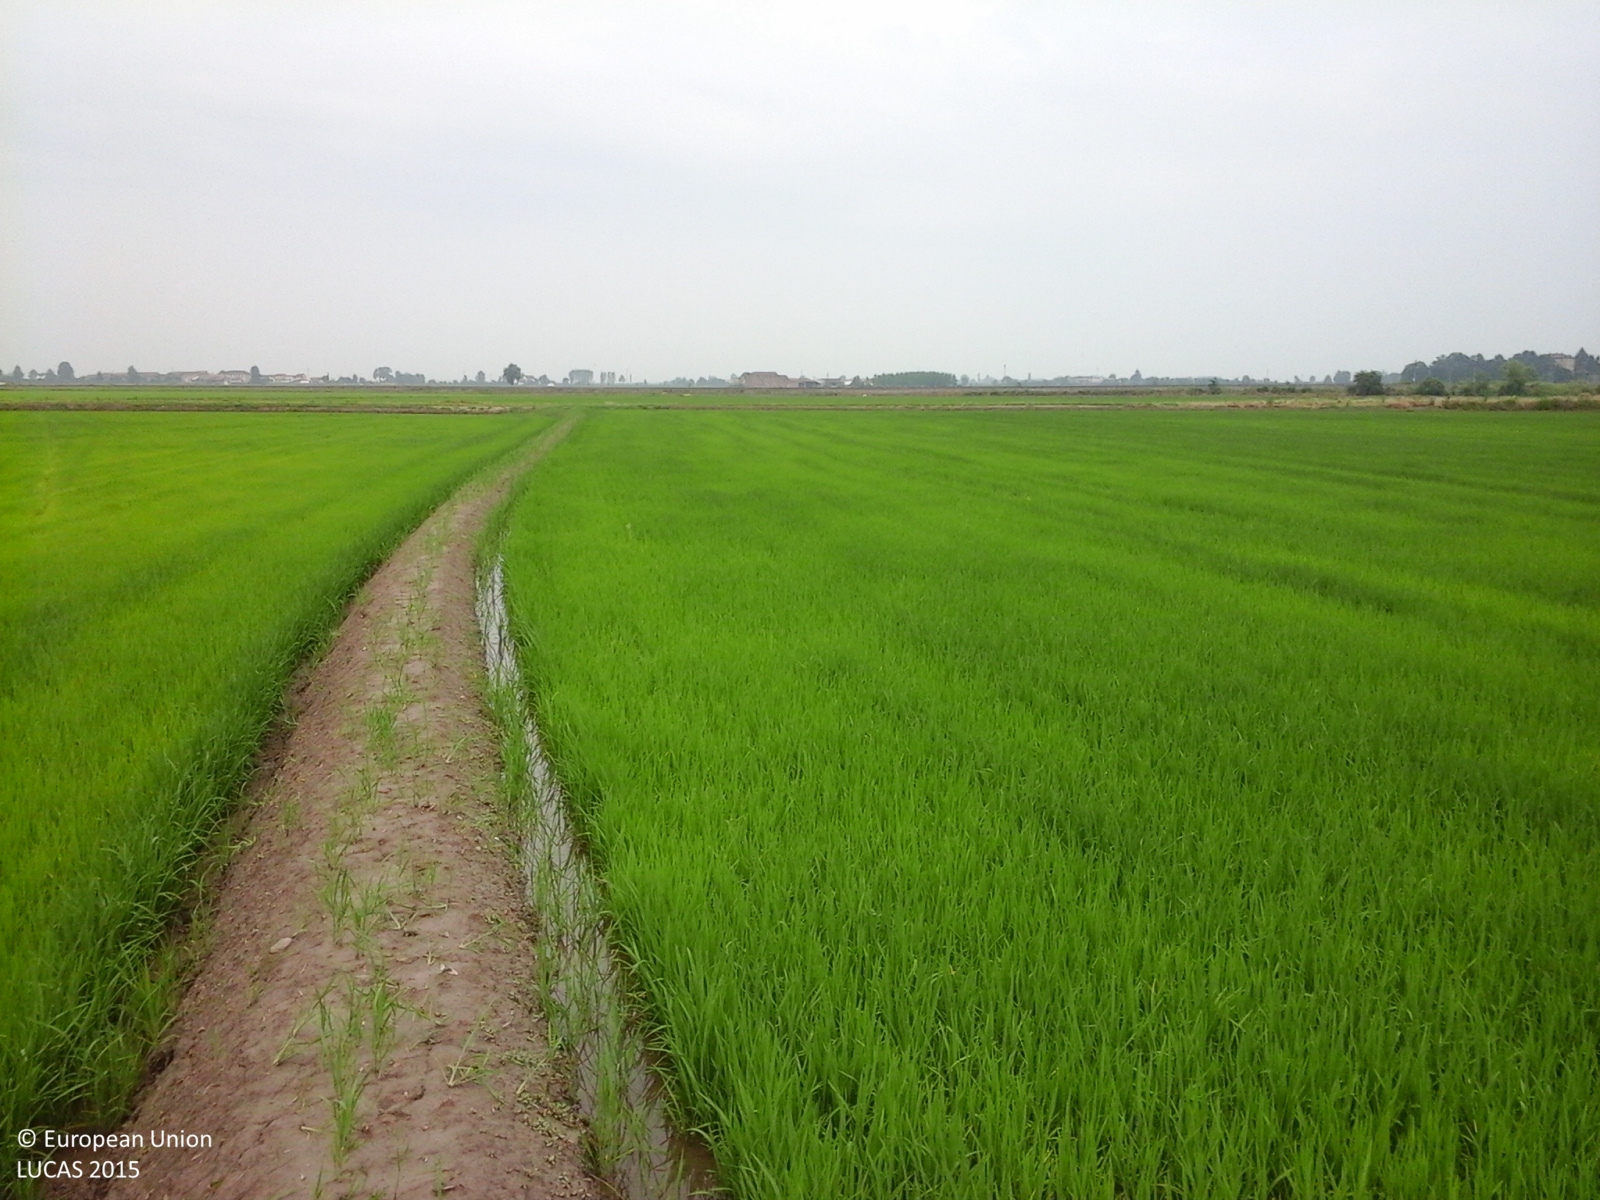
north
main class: Cropland
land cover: Rice
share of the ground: > 75 %
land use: Agriculture (excluding fallow land and kitchen gardens)
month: June
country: IT
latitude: 45.3136
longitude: 8.5102
